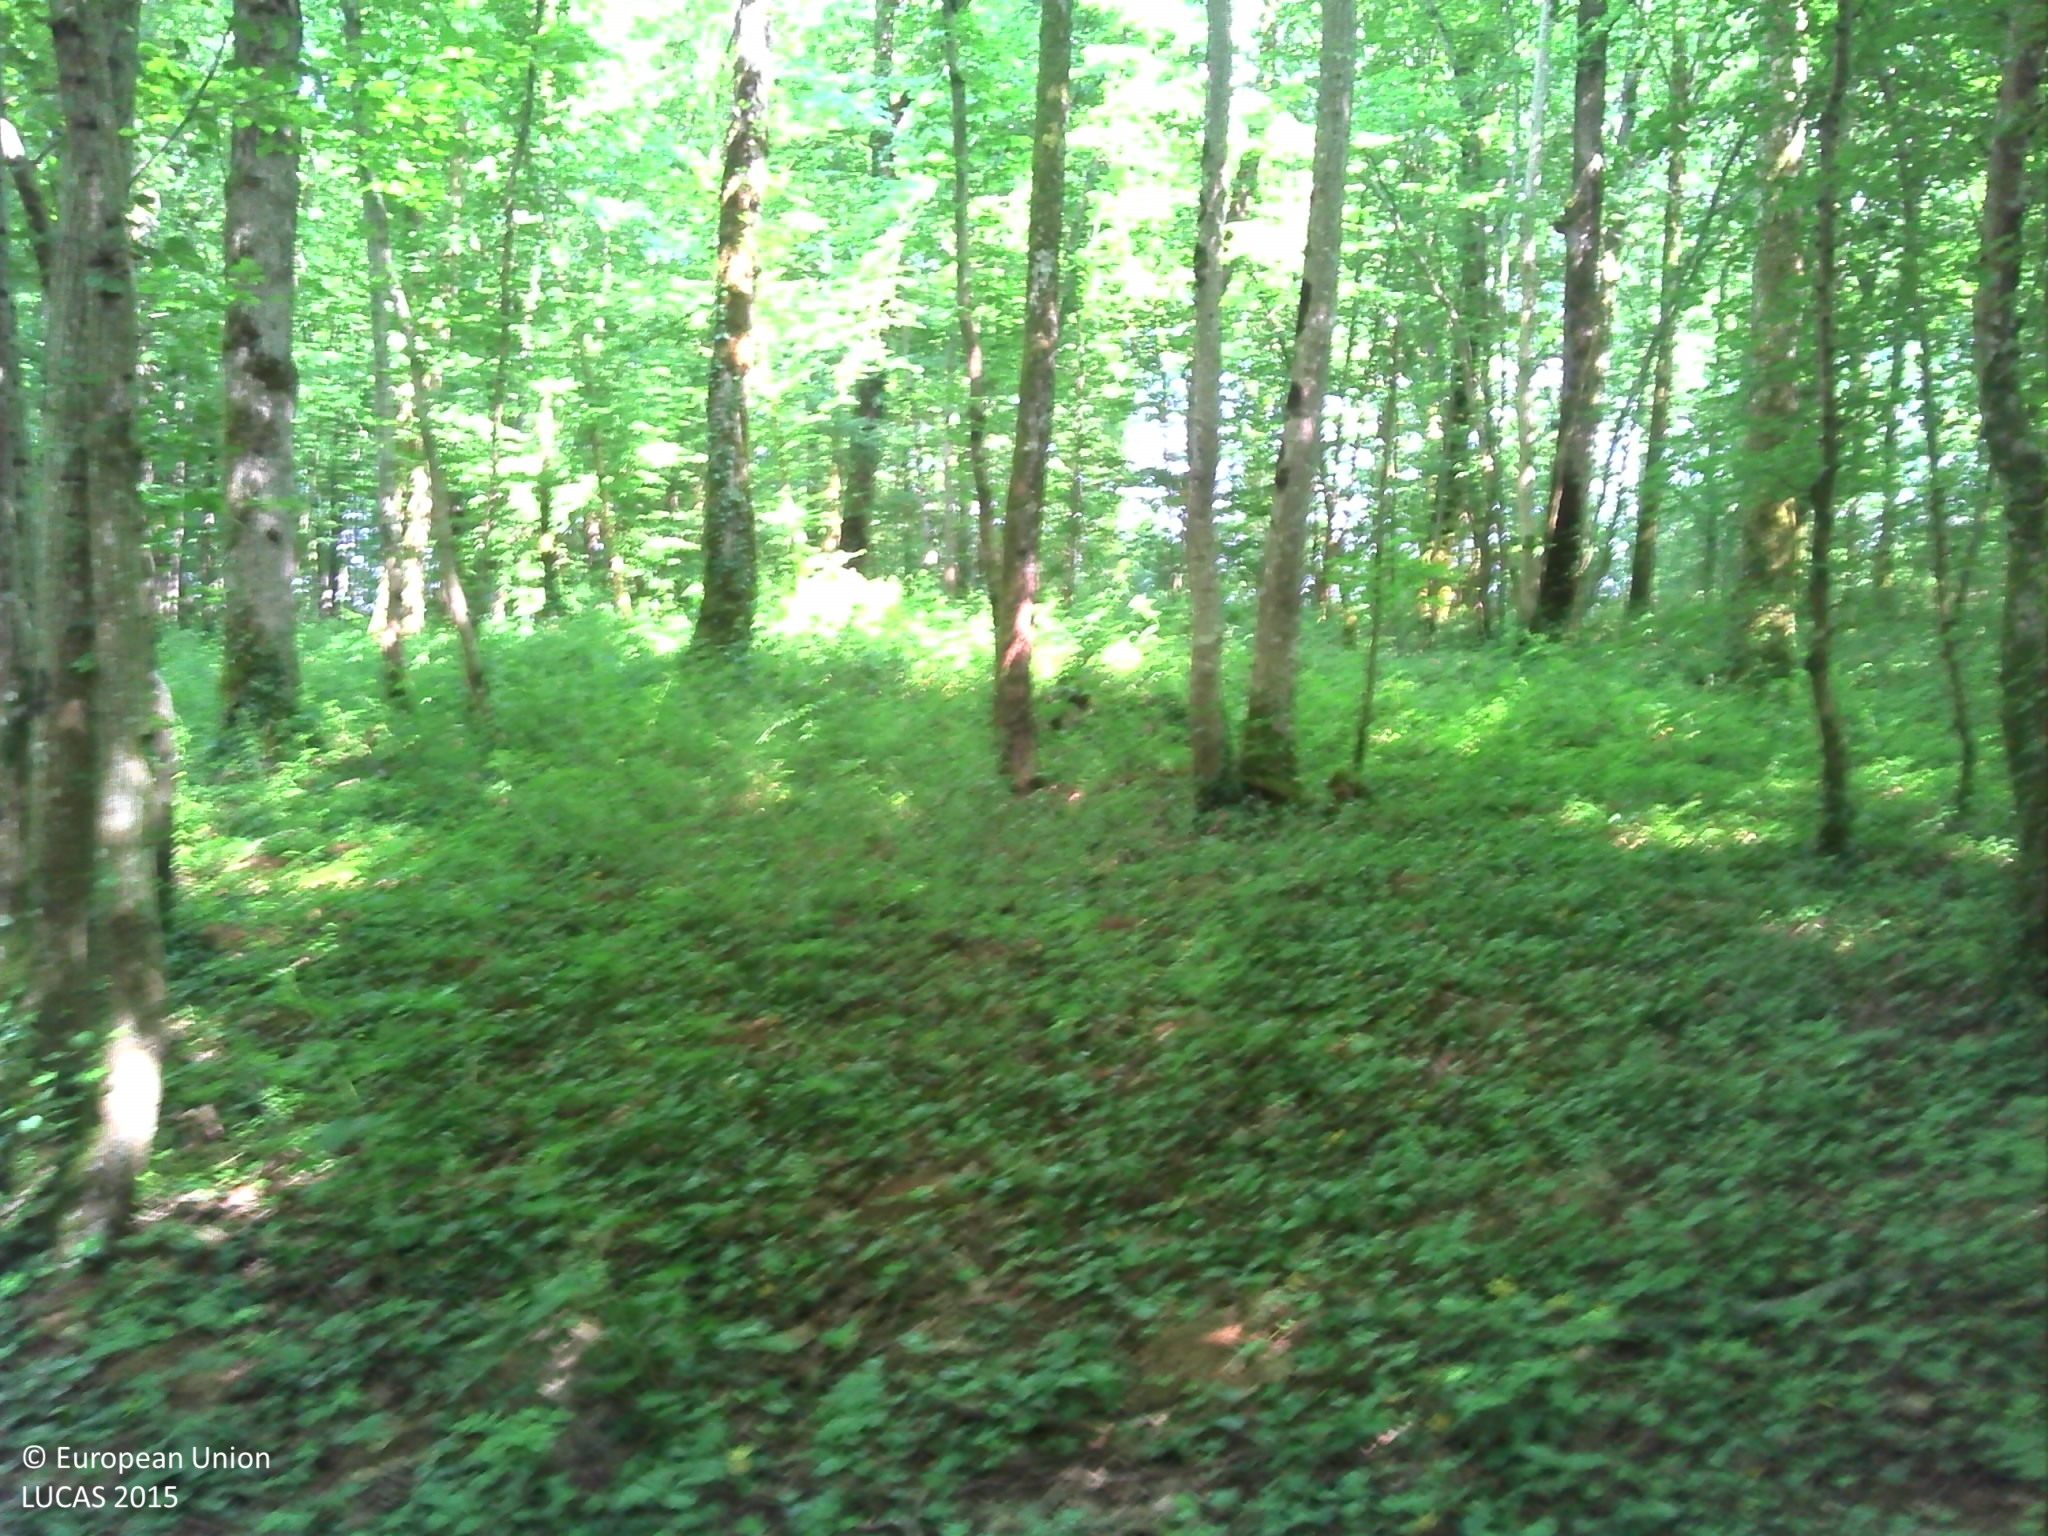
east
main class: Woodland
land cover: Broadleaved woodland
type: beech forest
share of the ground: > 75 %
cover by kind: broadleaved forest trees 95 %, herbaceous plants 5 %
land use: Forestry
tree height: > 5 m
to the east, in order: Broadleaved woodland; Tracks; Broadleaved woodland; Fences; Grassland without tree/shrub cover; Fences; Grass margins; Tracks; Grass margins; Fences; Single bushes/trees
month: June
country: FR
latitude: 47.5667
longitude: 6.2930
